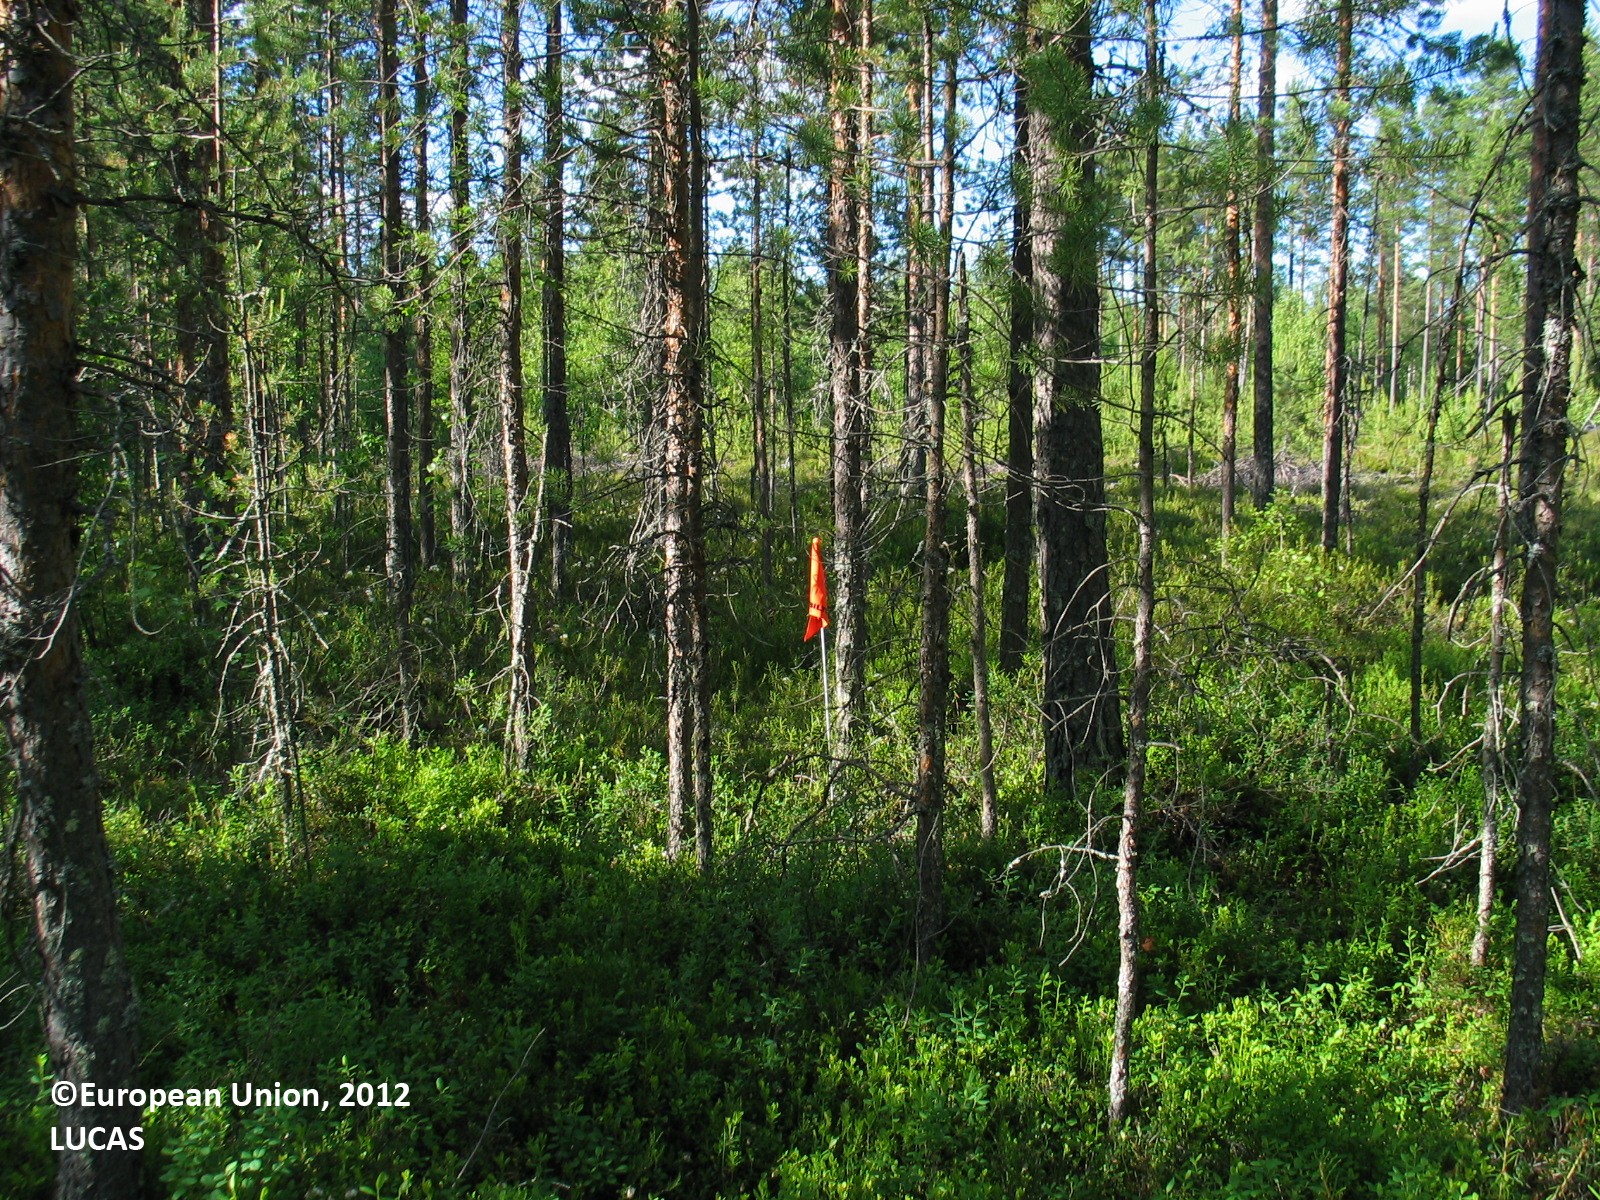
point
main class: Woodland
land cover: Pine dominated coniferous woodland
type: boreal forest
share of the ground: 50 - 75 %
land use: Forestry
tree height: > 5 m
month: July
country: FI
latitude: 64.6912
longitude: 26.7008
